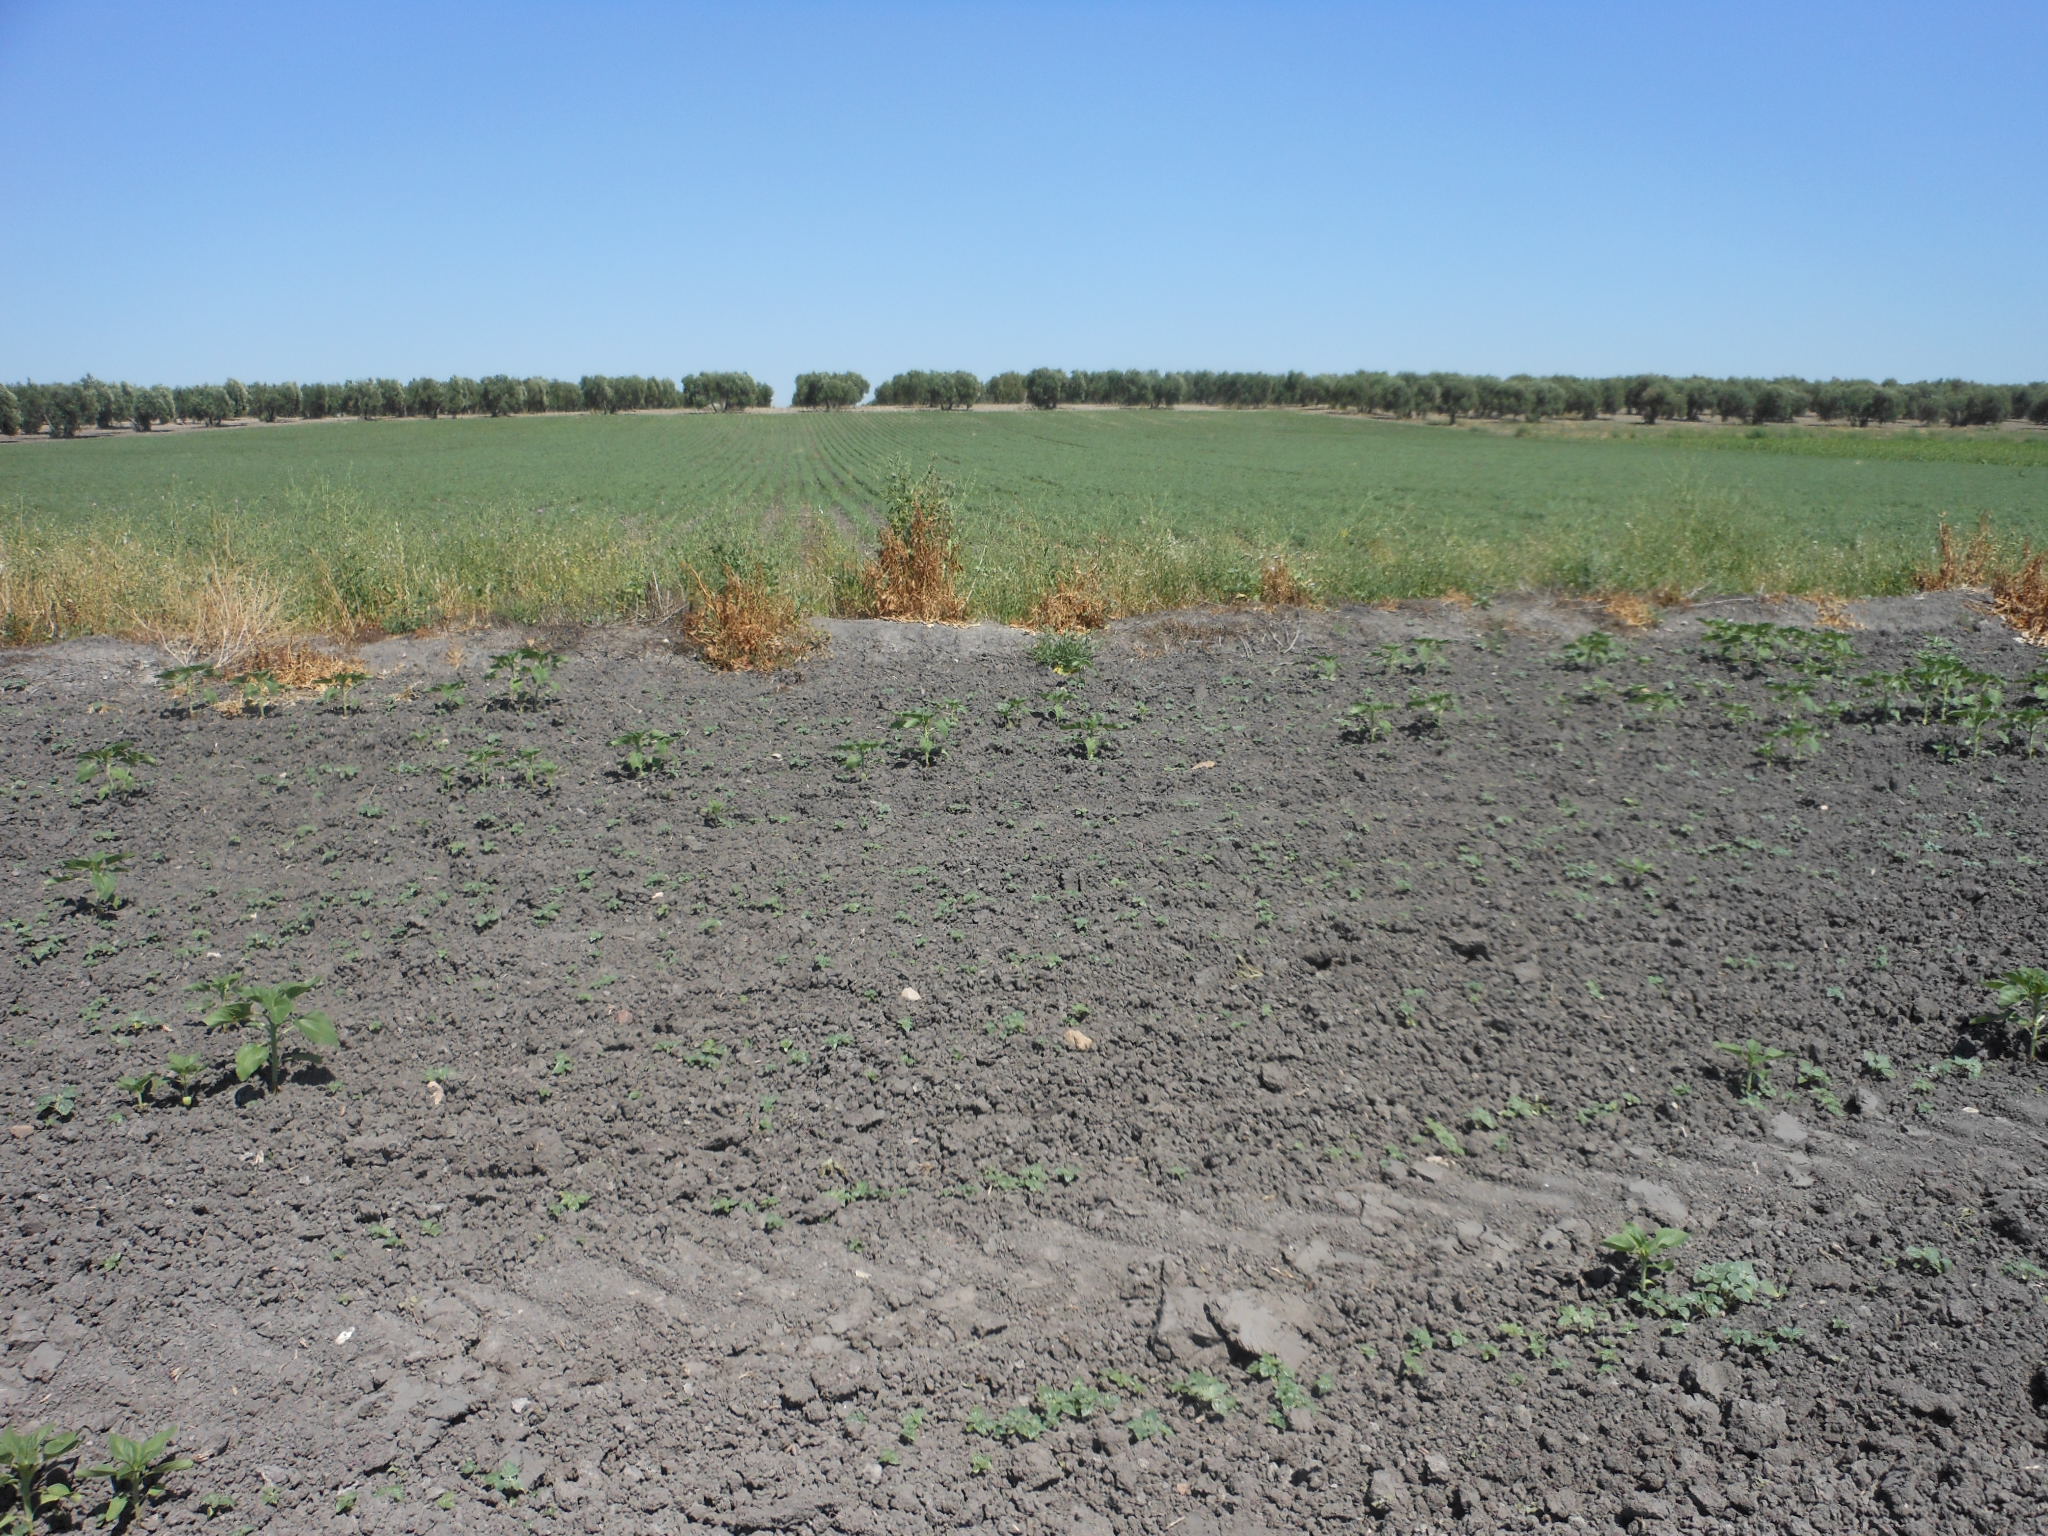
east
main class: Cropland
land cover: Sunflower
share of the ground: 10 - 25 %
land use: Agriculture (excluding fallow land and kitchen gardens)
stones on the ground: < 10 %
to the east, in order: Sunflower; Grass margins; Dry pulses; Olive groves
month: May
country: ES
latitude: 37.2895
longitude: -5.5473
